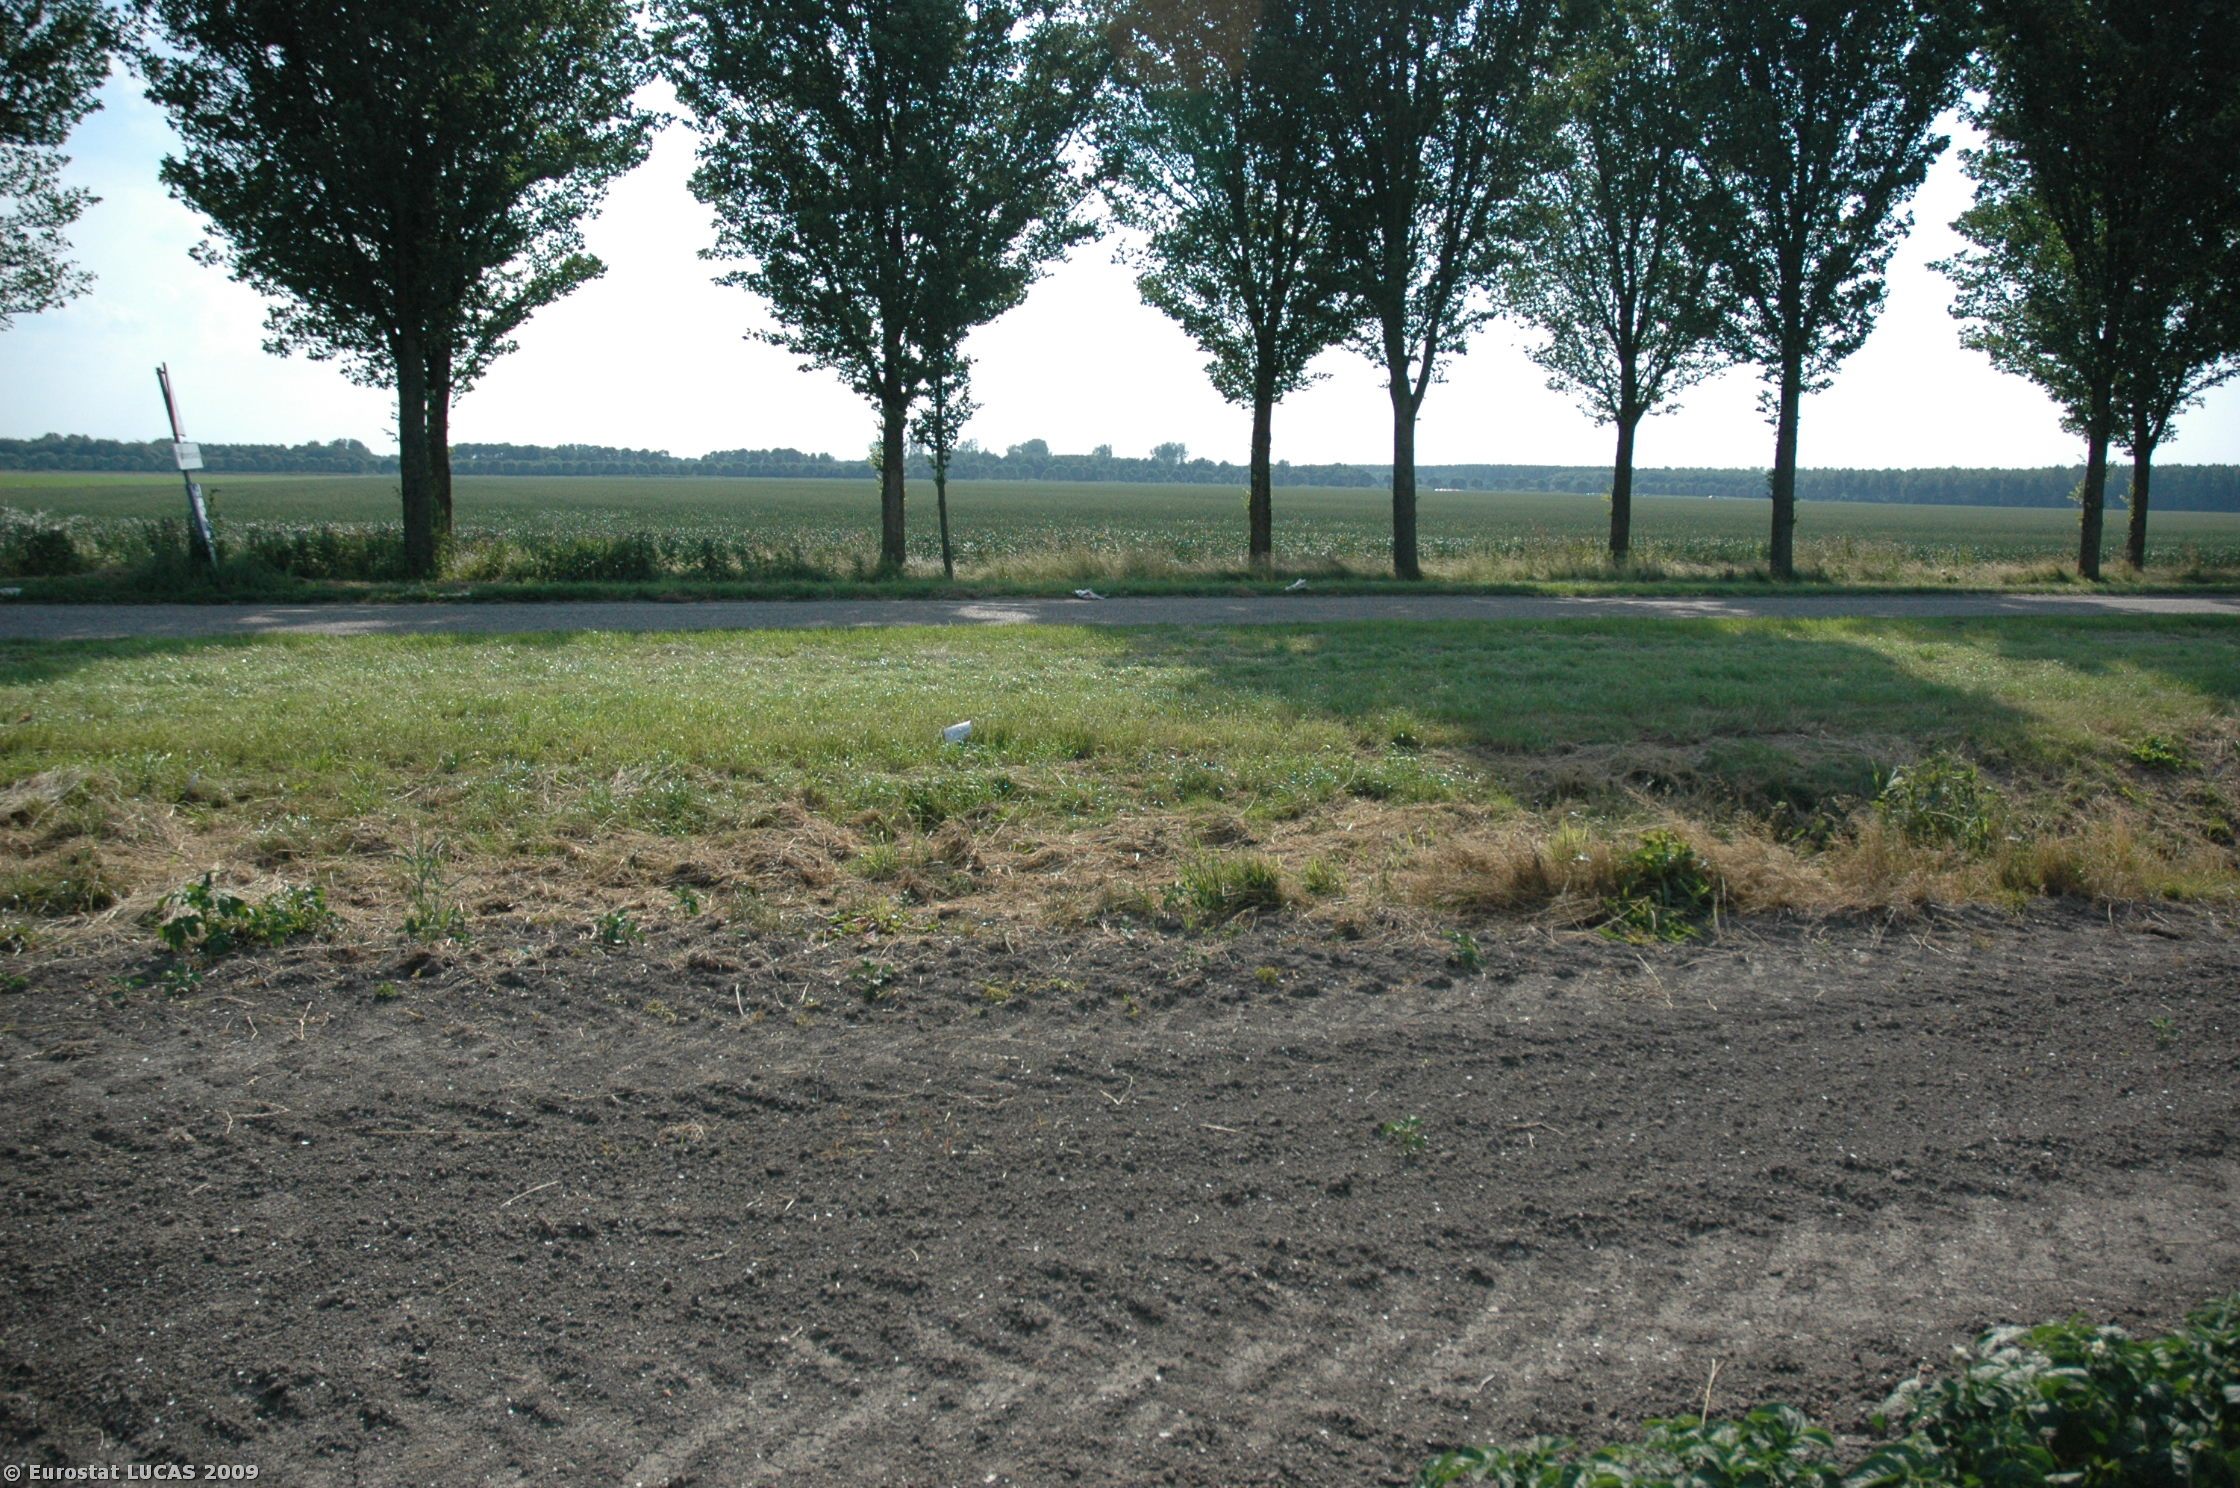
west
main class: Cropland
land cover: Potatoes
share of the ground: > 75 %
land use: Agriculture (excluding fallow land and kitchen gardens)
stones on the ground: < 10 %
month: June
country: NL
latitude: 52.3570
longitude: 5.3141
